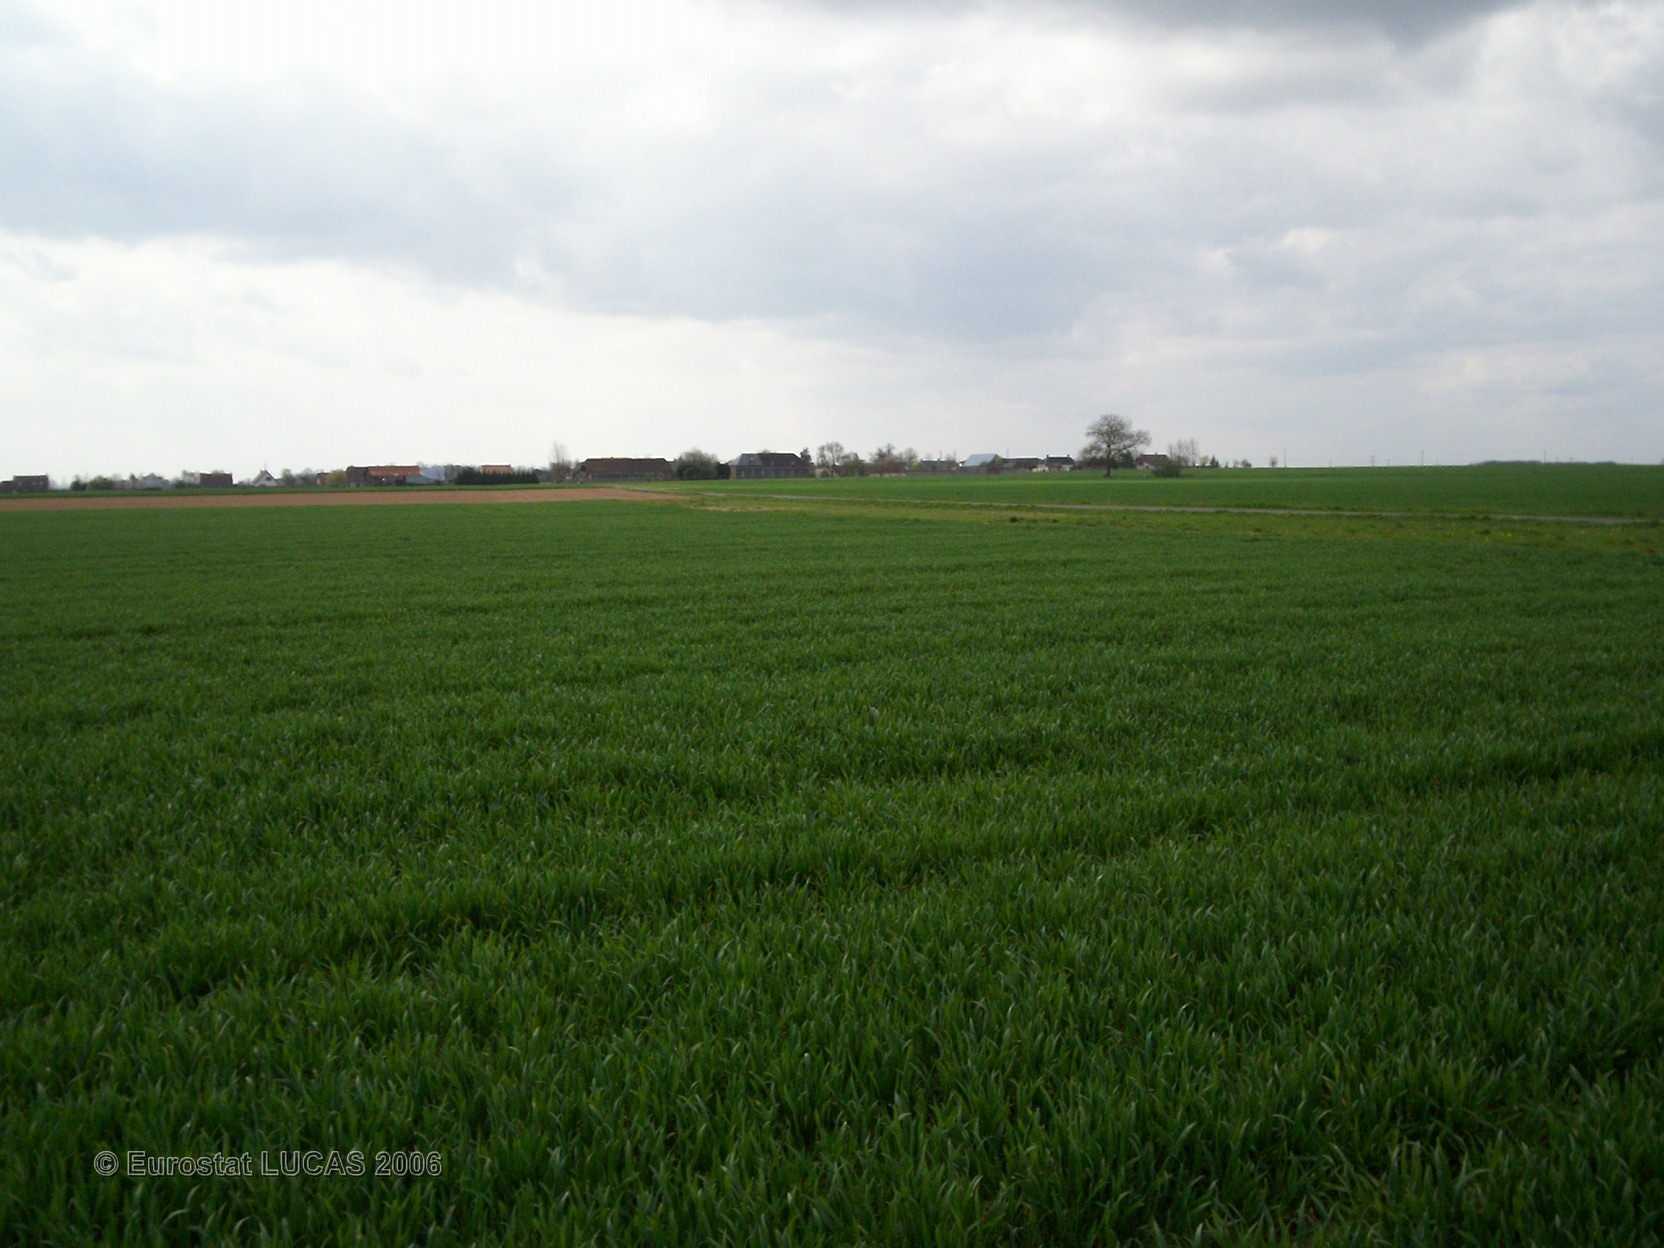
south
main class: Cropland
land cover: Common wheat
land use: Agriculture (excluding fallow land and kitchen gardens)
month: April
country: FR
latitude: 49.0530
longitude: 1.0434
